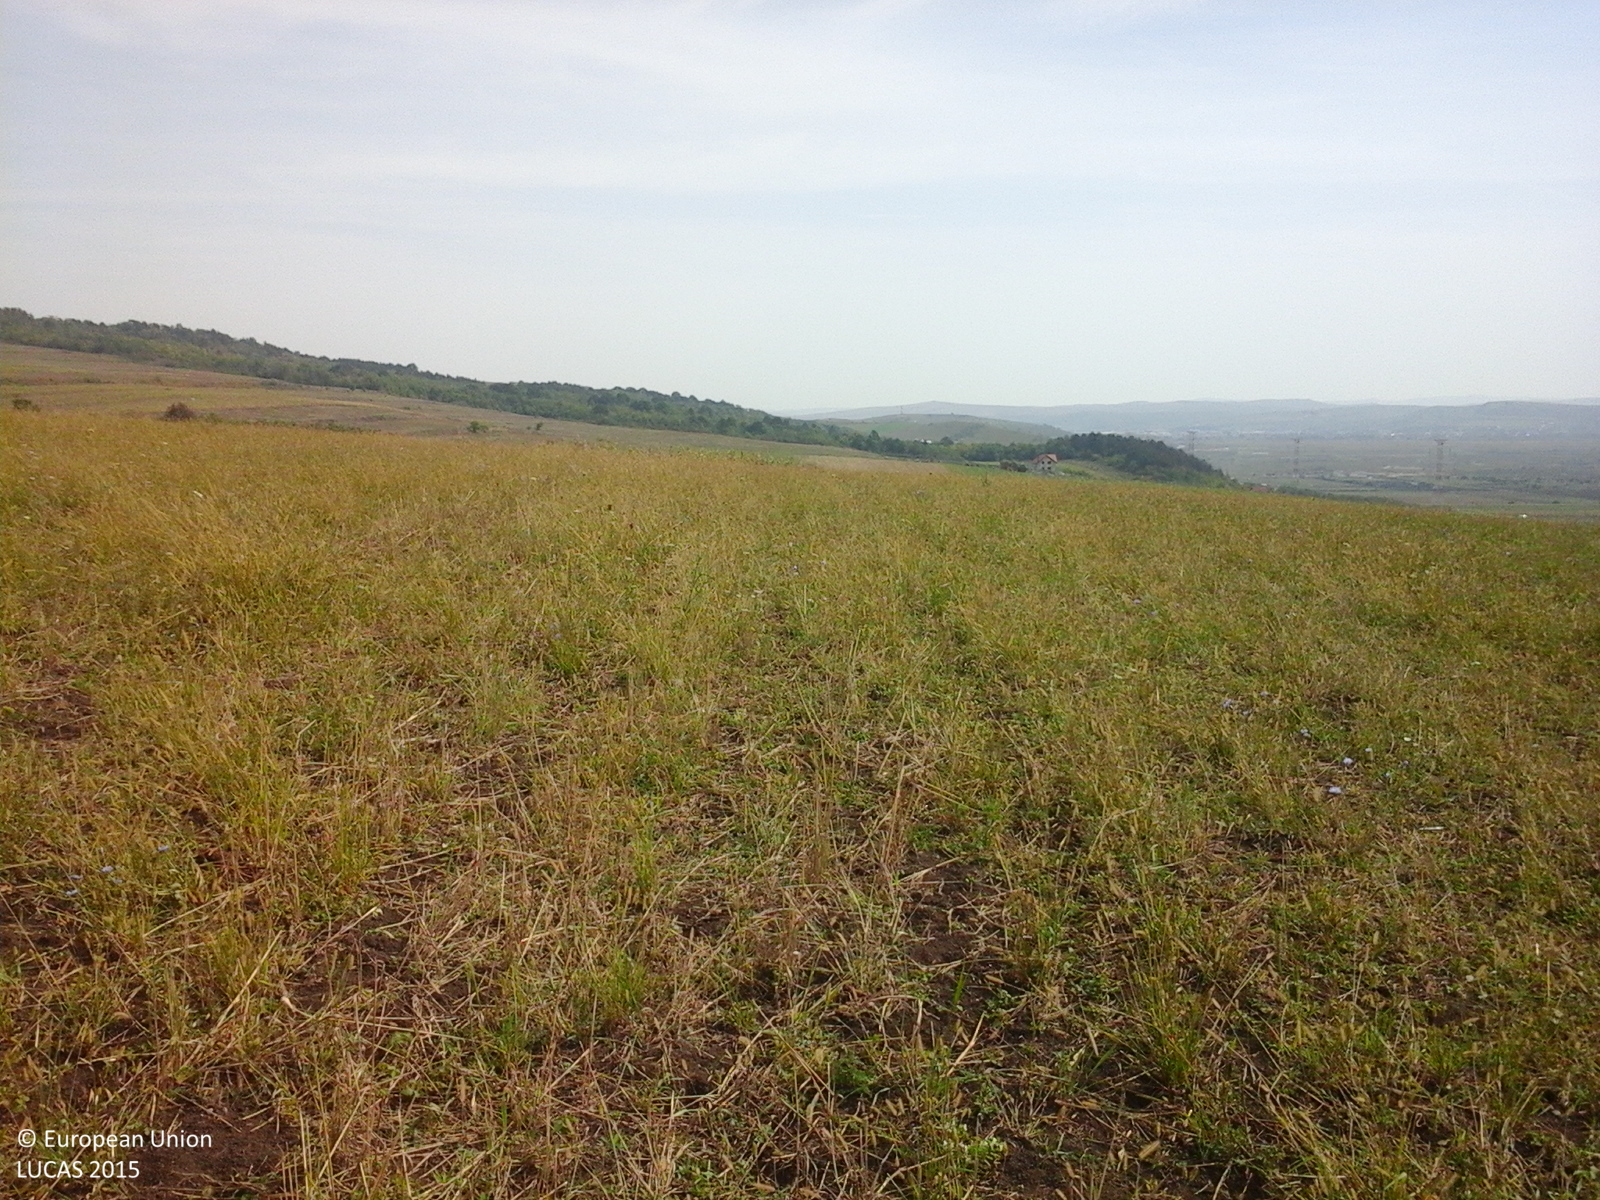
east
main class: Grassland
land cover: Grassland without tree/shrub cover
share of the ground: > 75 %
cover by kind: herbaceous plants 100 %
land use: Agriculture (excluding fallow land and kitchen gardens)
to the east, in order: Grassland without tree/shrub cover; Tracks; Grassland without tree/shrub cover
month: September
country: RO
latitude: 46.8025
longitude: 23.6603
